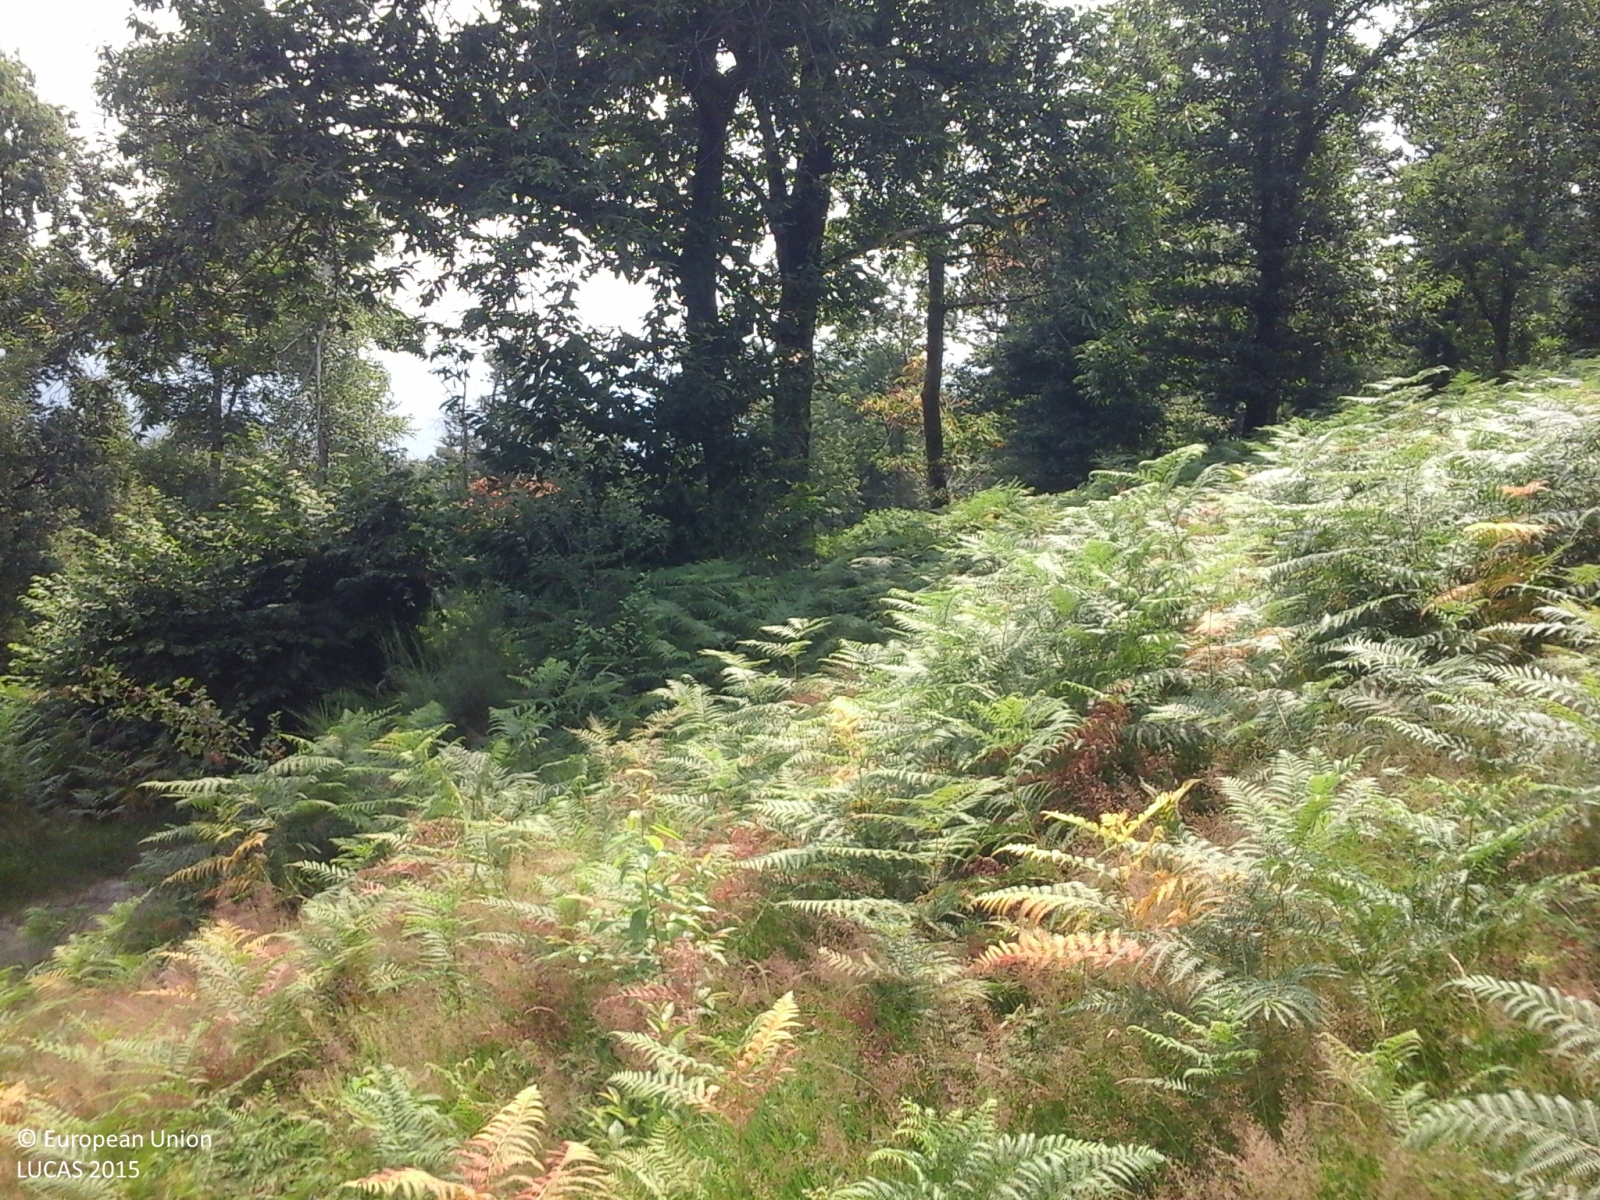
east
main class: Grassland
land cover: Grassland with sparse tree/shrub cover
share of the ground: > 75 %
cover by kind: herbaceous plants 95 %, broadleaved forest trees 5 %
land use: Semi-natural and natural areas not in use
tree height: > 5 m
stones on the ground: < 10 %
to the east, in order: Grassland with sparse tree/shrub cover; Tracks; Grassland with sparse tree/shrub cover; Tracks; Broadleaved woodland
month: July
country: IT
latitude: 45.9652
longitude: 8.7243
